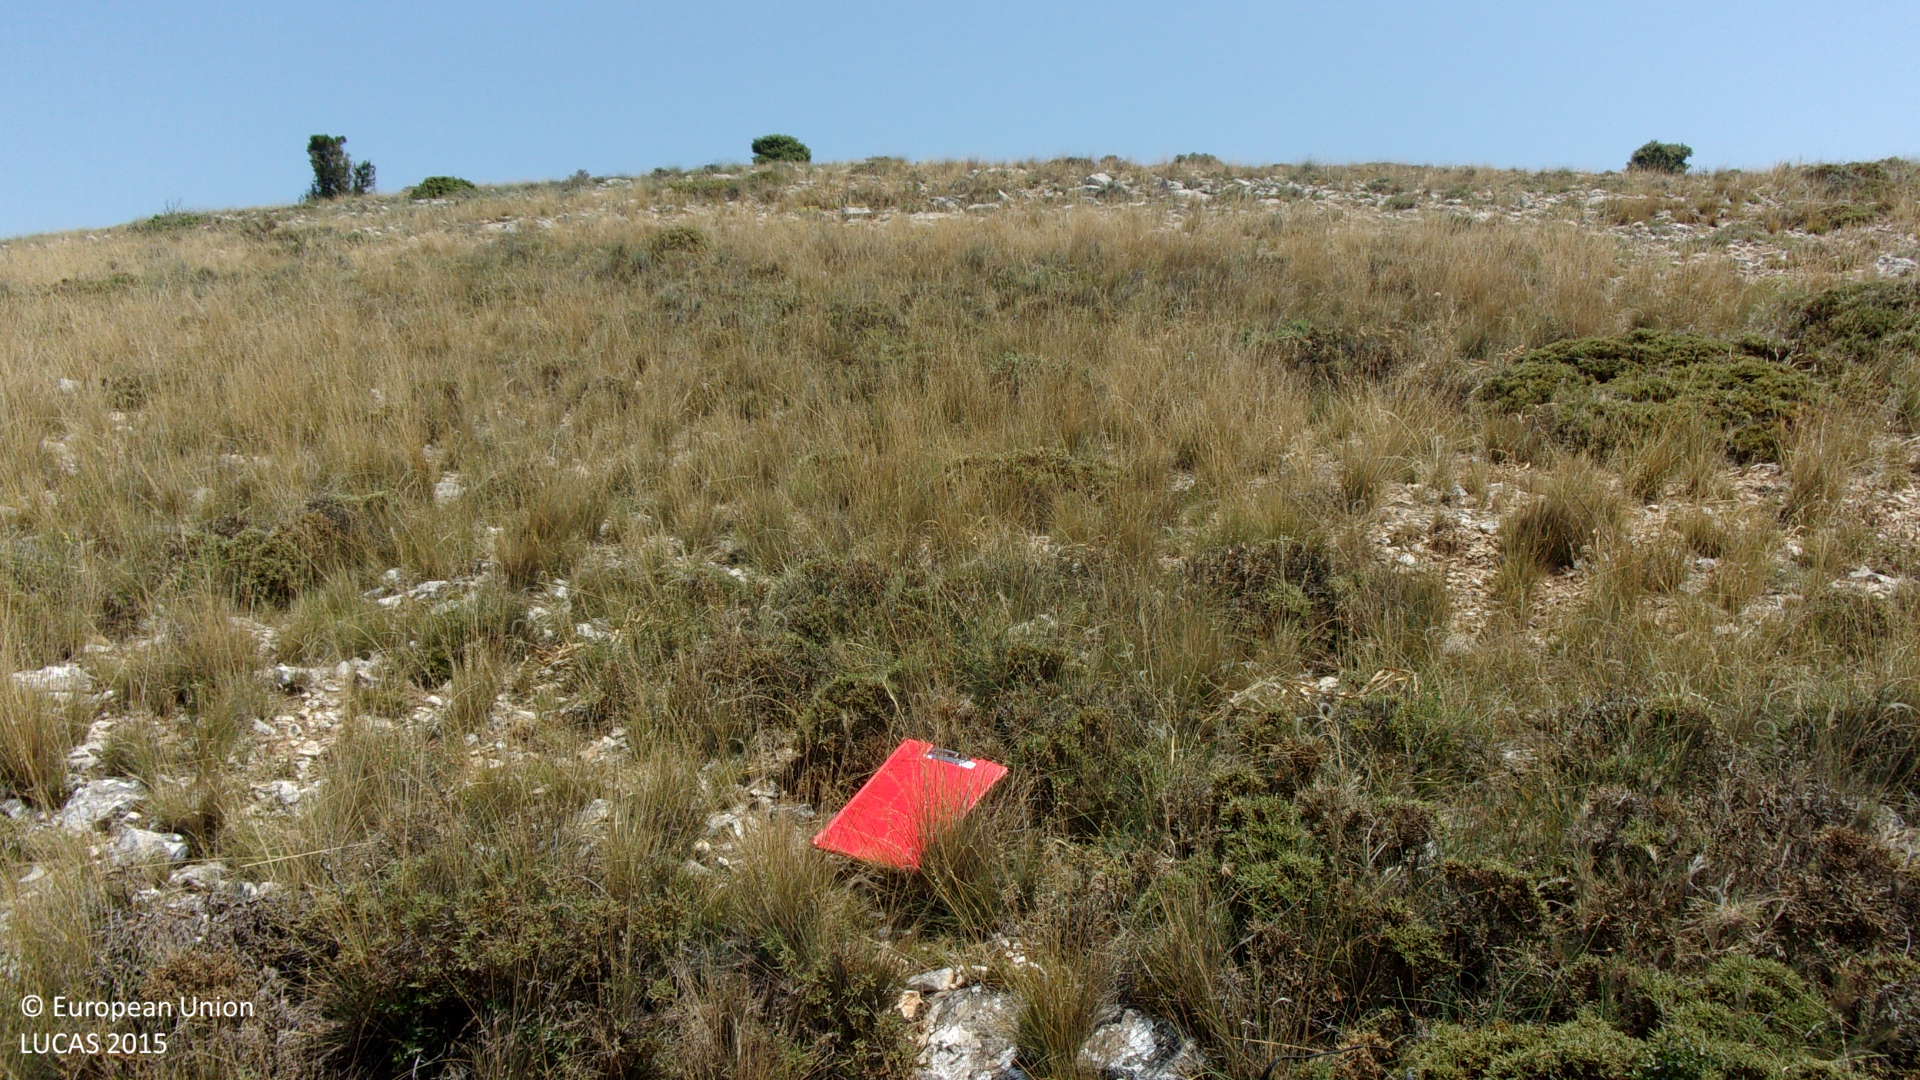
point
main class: Shrubland
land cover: Shrubland without tree cover
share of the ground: > 75 %
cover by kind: shrubs 65 %, consolidated bare surface 20 %, herbaceous plants 15 %
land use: Semi-natural and natural areas not in use
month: July
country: ES
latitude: 41.5830
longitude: -1.9171
